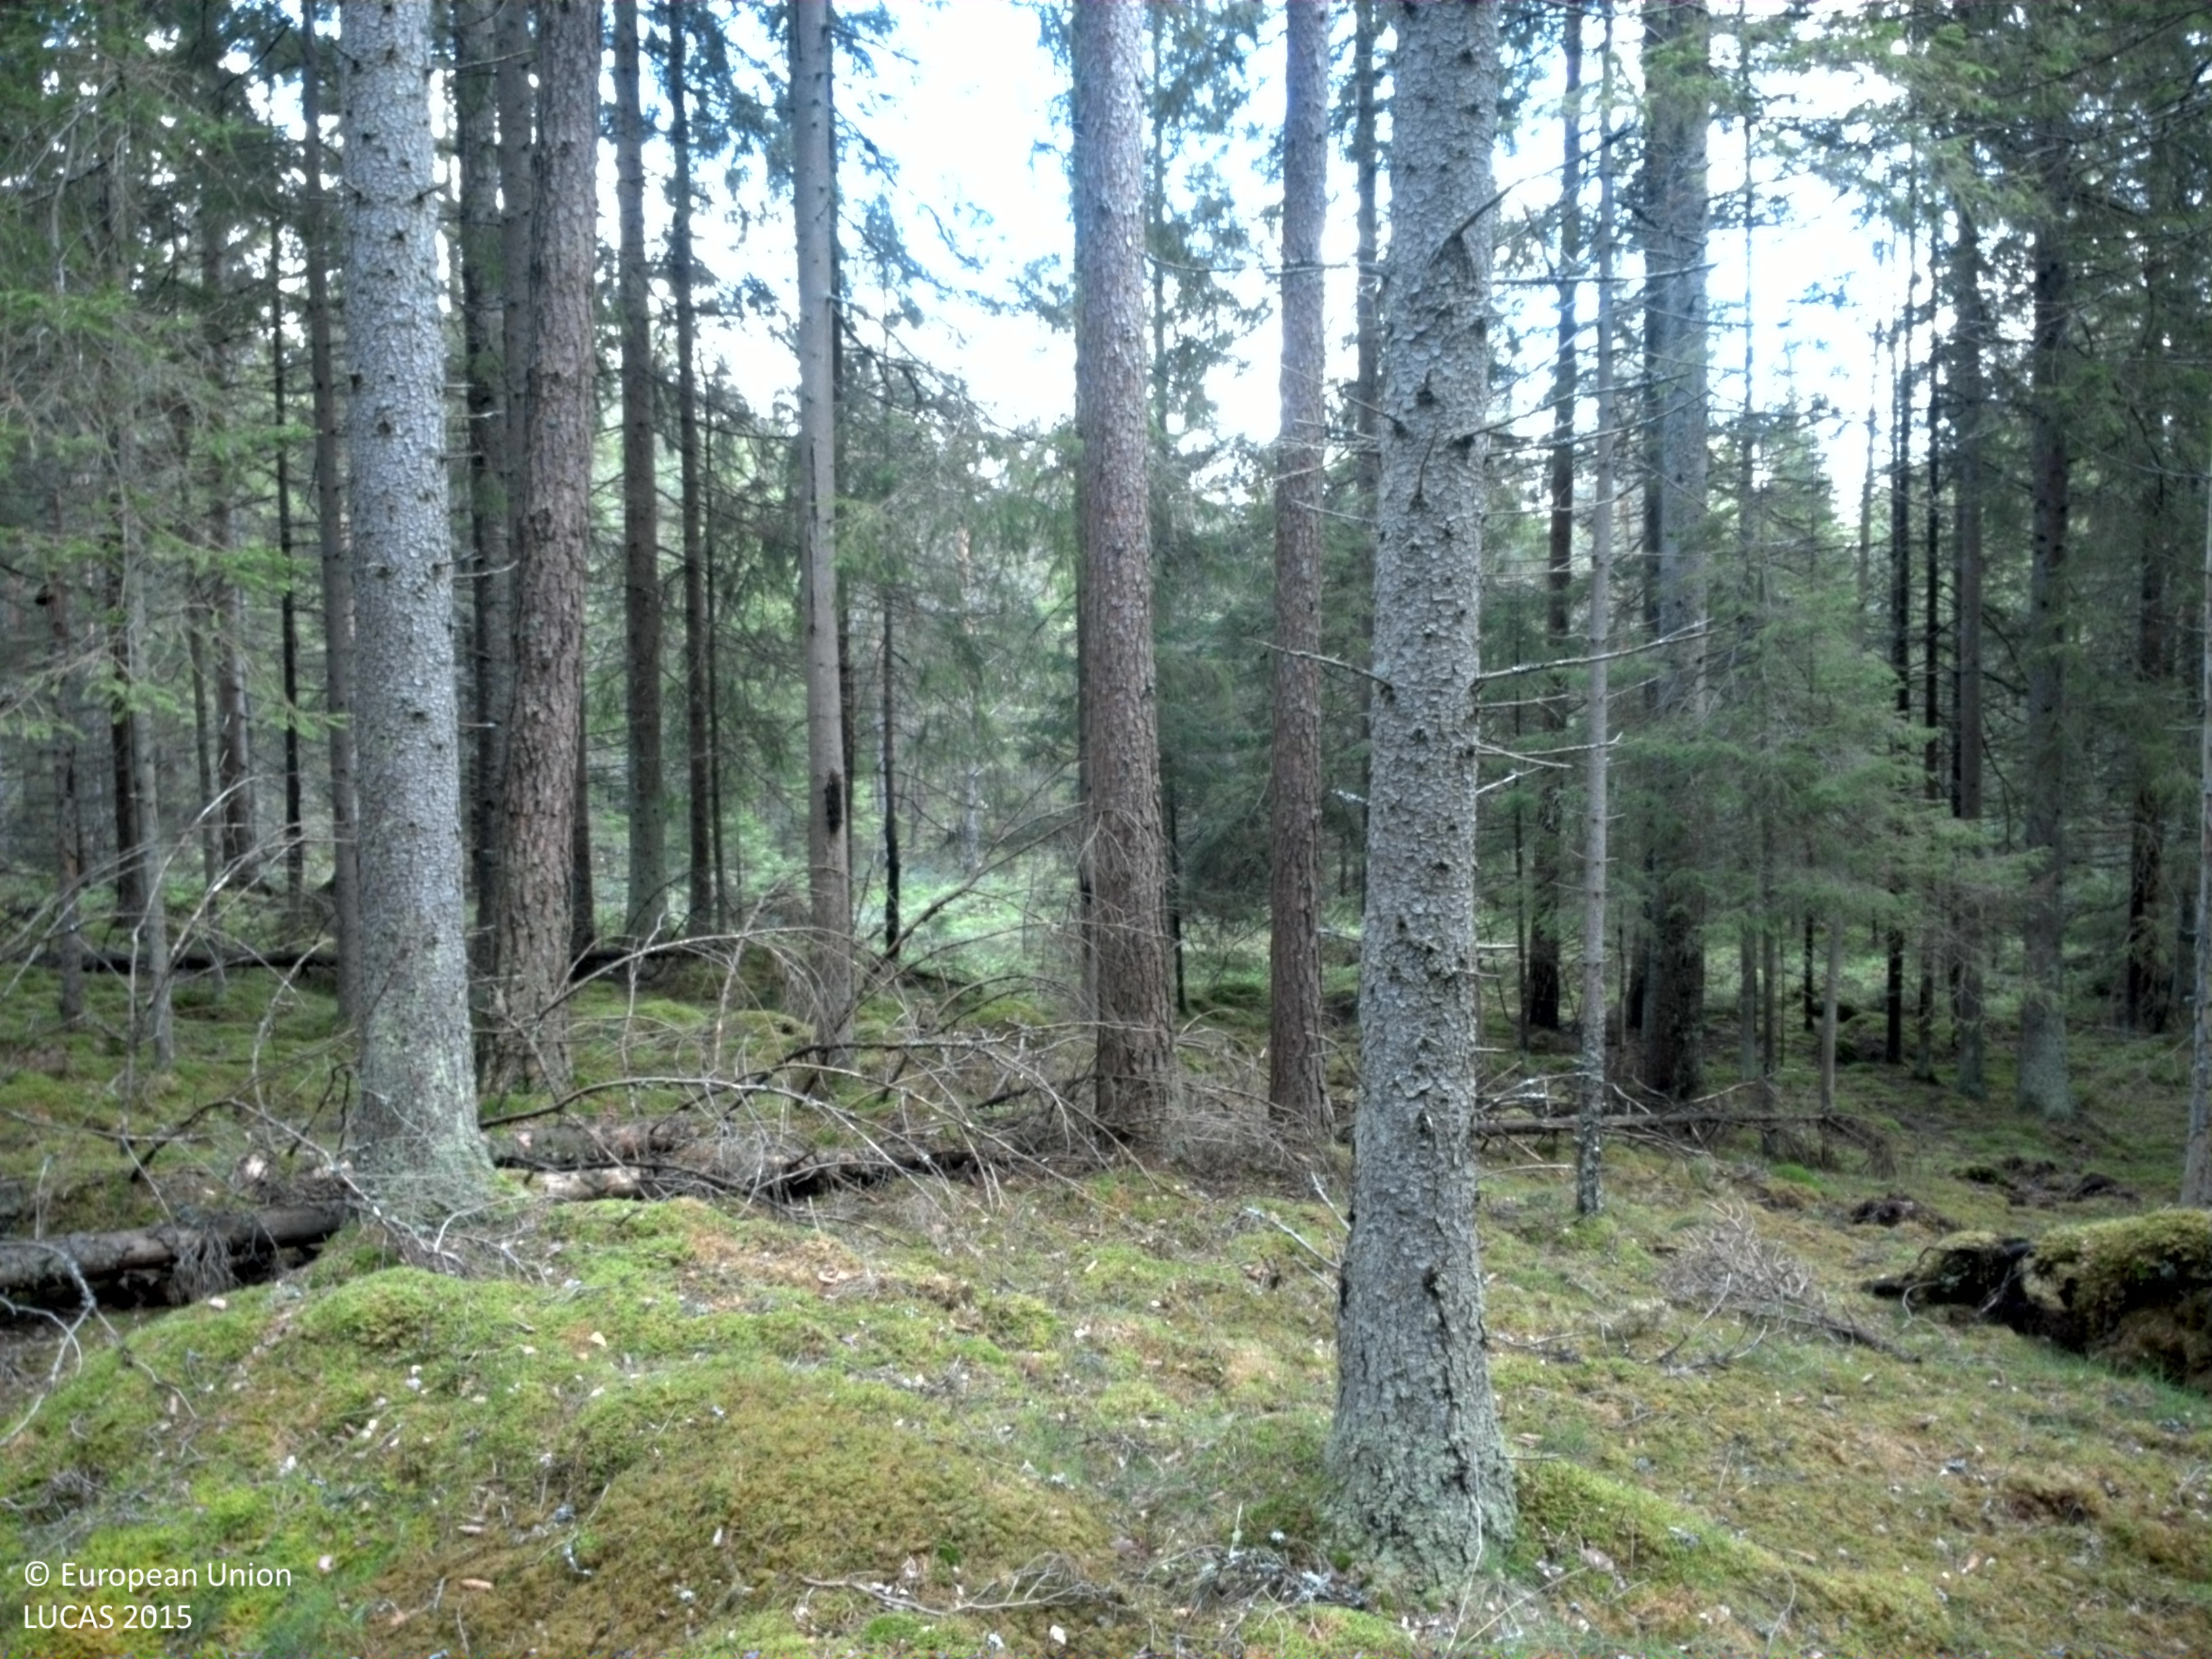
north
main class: Woodland
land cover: Spruce dominated coniferous woodland
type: boreal forest
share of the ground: 50 - 75 %
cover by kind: coniferous forest trees 55 %, lichens and mosses 35 %, shrubs 5 %, herbaceous plants 5 %
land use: Forestry
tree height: > 5 m
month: May
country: SE
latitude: 56.8434
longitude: 15.0961
